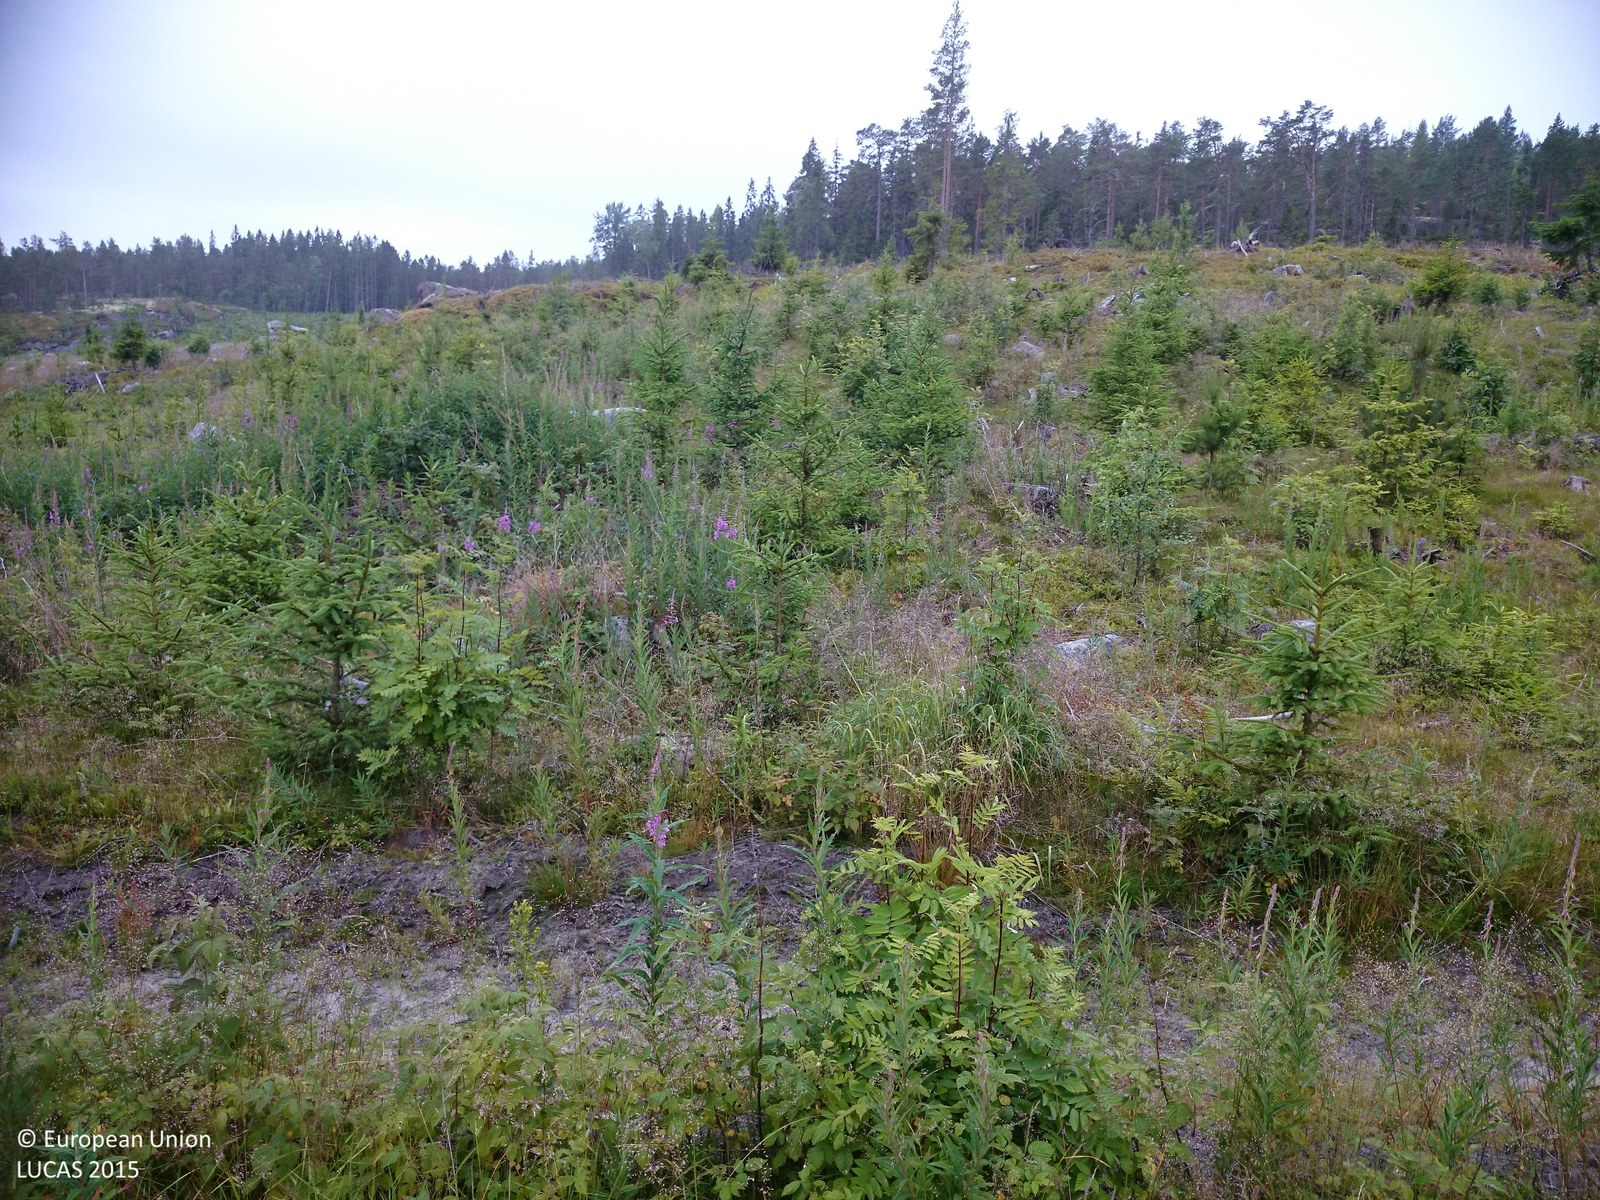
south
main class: Woodland
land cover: Pine dominated mixed woodland
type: boreal forest
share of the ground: 10 - 25 %
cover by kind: shrubs 40 %, herbaceous plants 40 %, coniferous forest trees 10 %, broadleaved forest trees 10 %
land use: Forestry
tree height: < 5 m
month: July
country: SE
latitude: 62.5522
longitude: 17.8565
